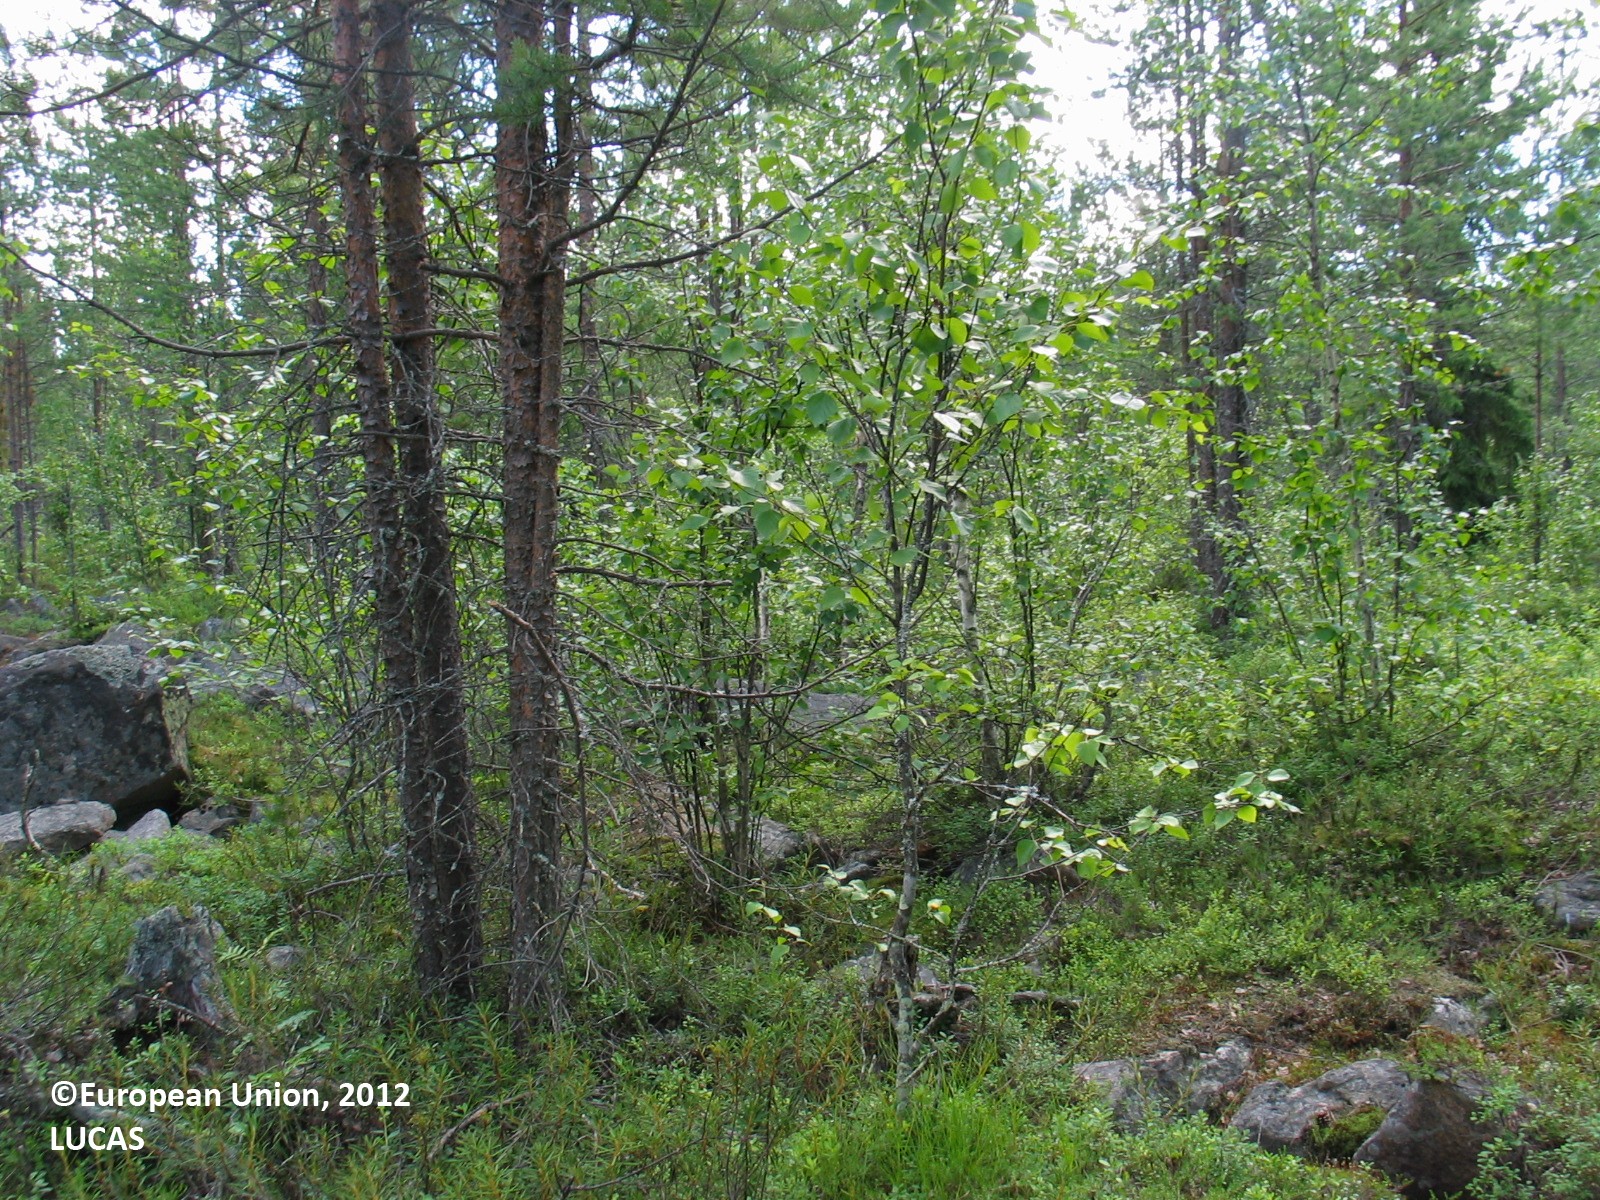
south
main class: Woodland
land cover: Pine dominated mixed woodland
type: boreal forest
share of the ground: 25 - 50 %
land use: Forestry
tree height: > 5 m
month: July
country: FI
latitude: 65.8043
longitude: 24.9975
